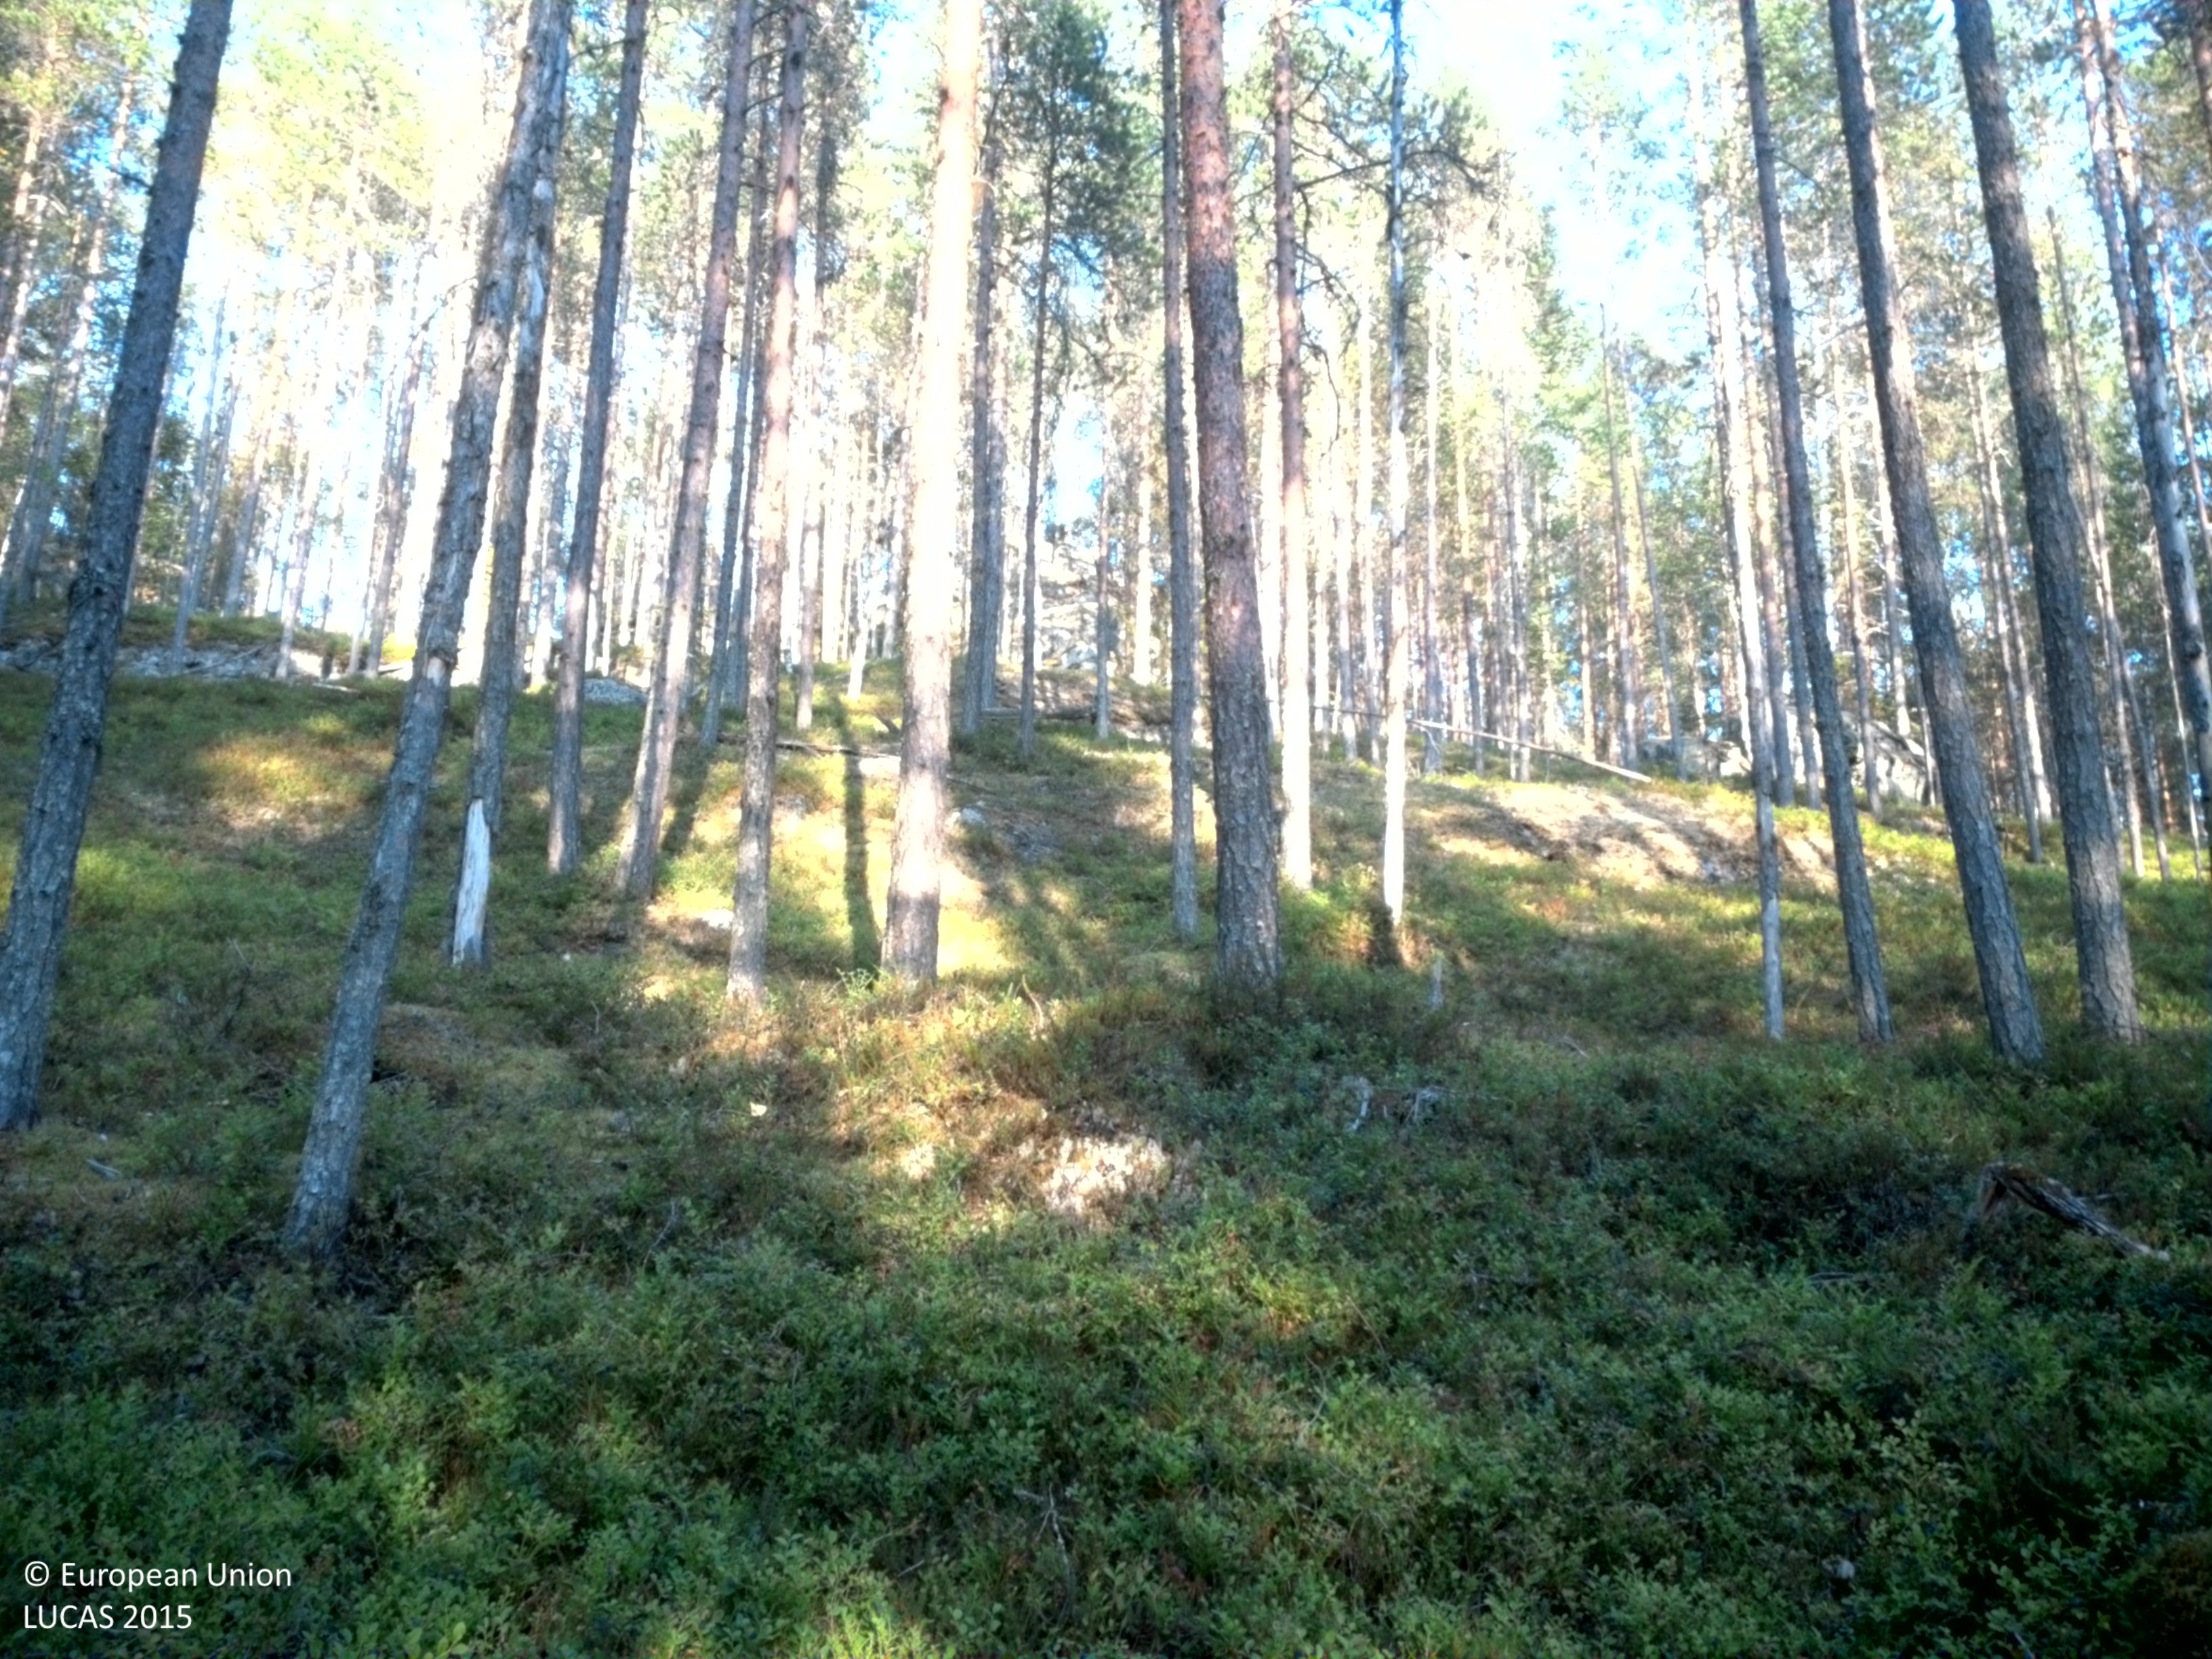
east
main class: Woodland
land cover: Pine dominated coniferous woodland
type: boreal forest
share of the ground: 25 - 50 %
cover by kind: coniferous forest trees 50 %, shrubs 50 %
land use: Forestry
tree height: > 5 m
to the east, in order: Pine dominated coniferous woodland; Pine dominated mixed woodland; Other mixed woodland
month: August
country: SE
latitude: 64.4666
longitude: 19.0568
